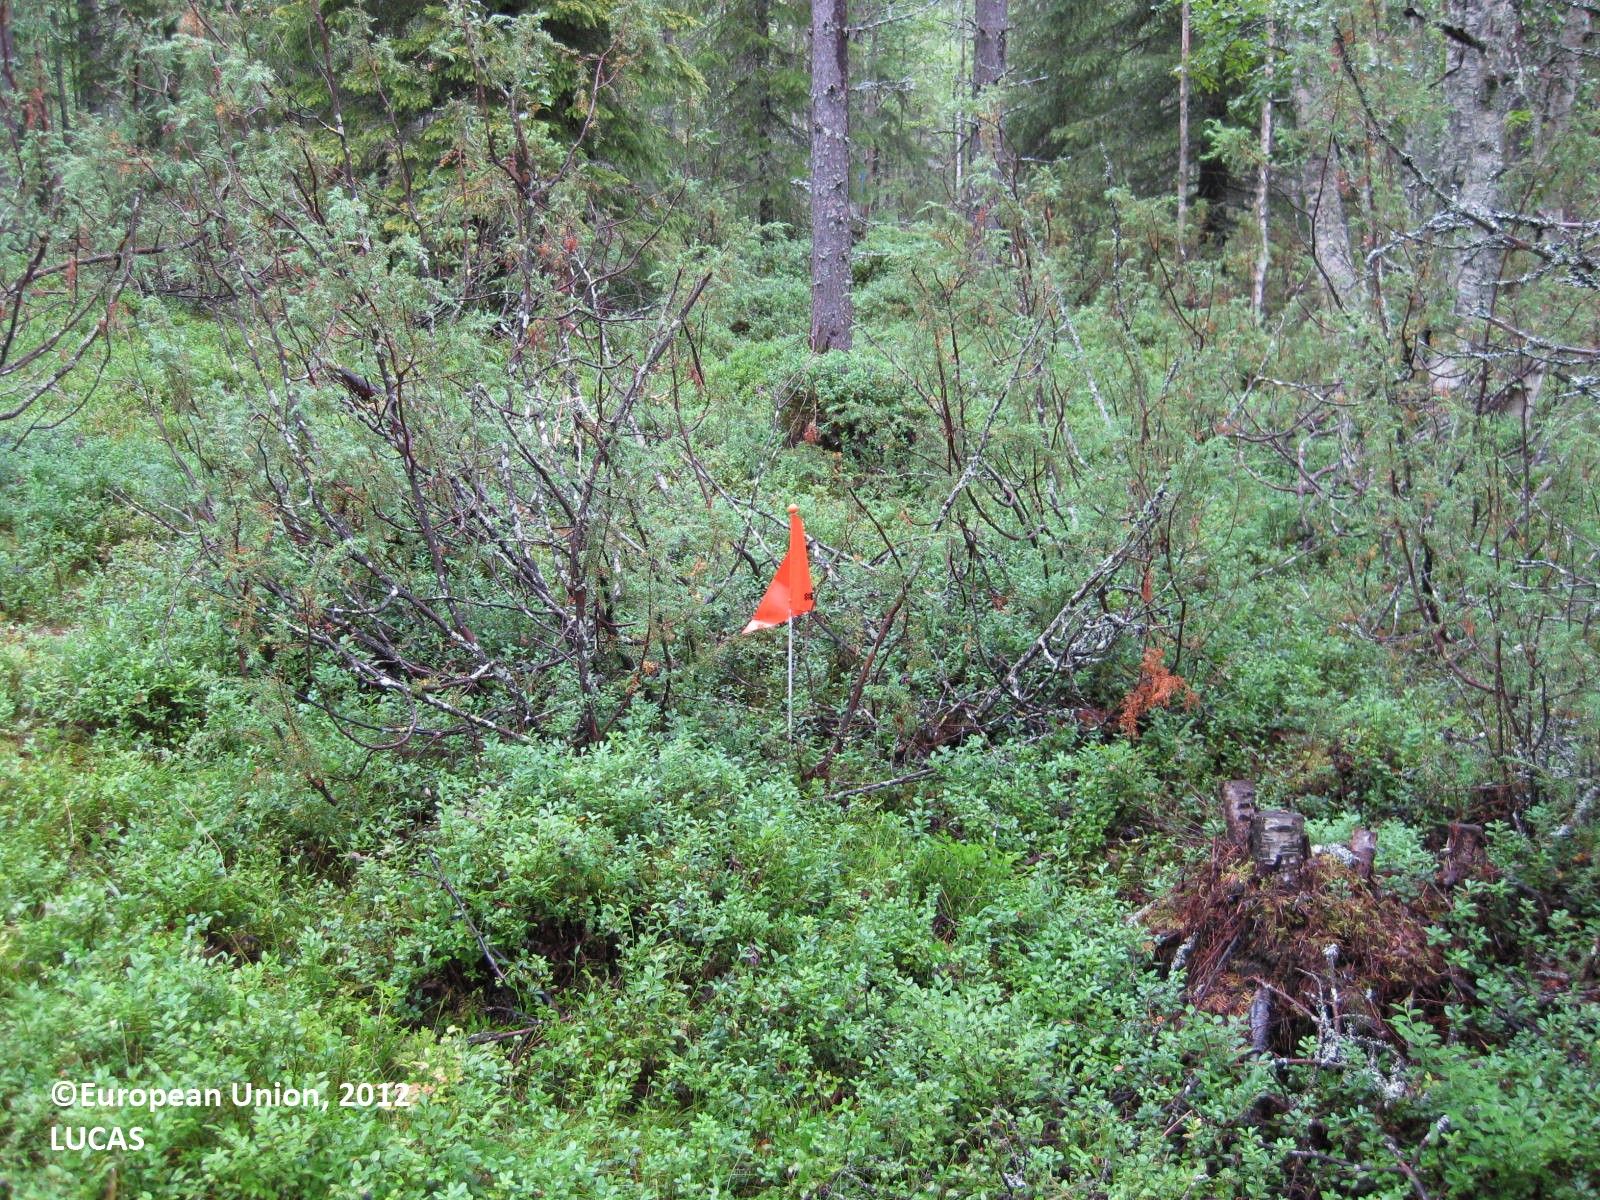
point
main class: Woodland
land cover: Other mixed woodland
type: boreal forest
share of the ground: 50 - 75 %
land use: Forestry
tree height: > 5 m
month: August
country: FI
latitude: 65.8118
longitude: 28.0554
